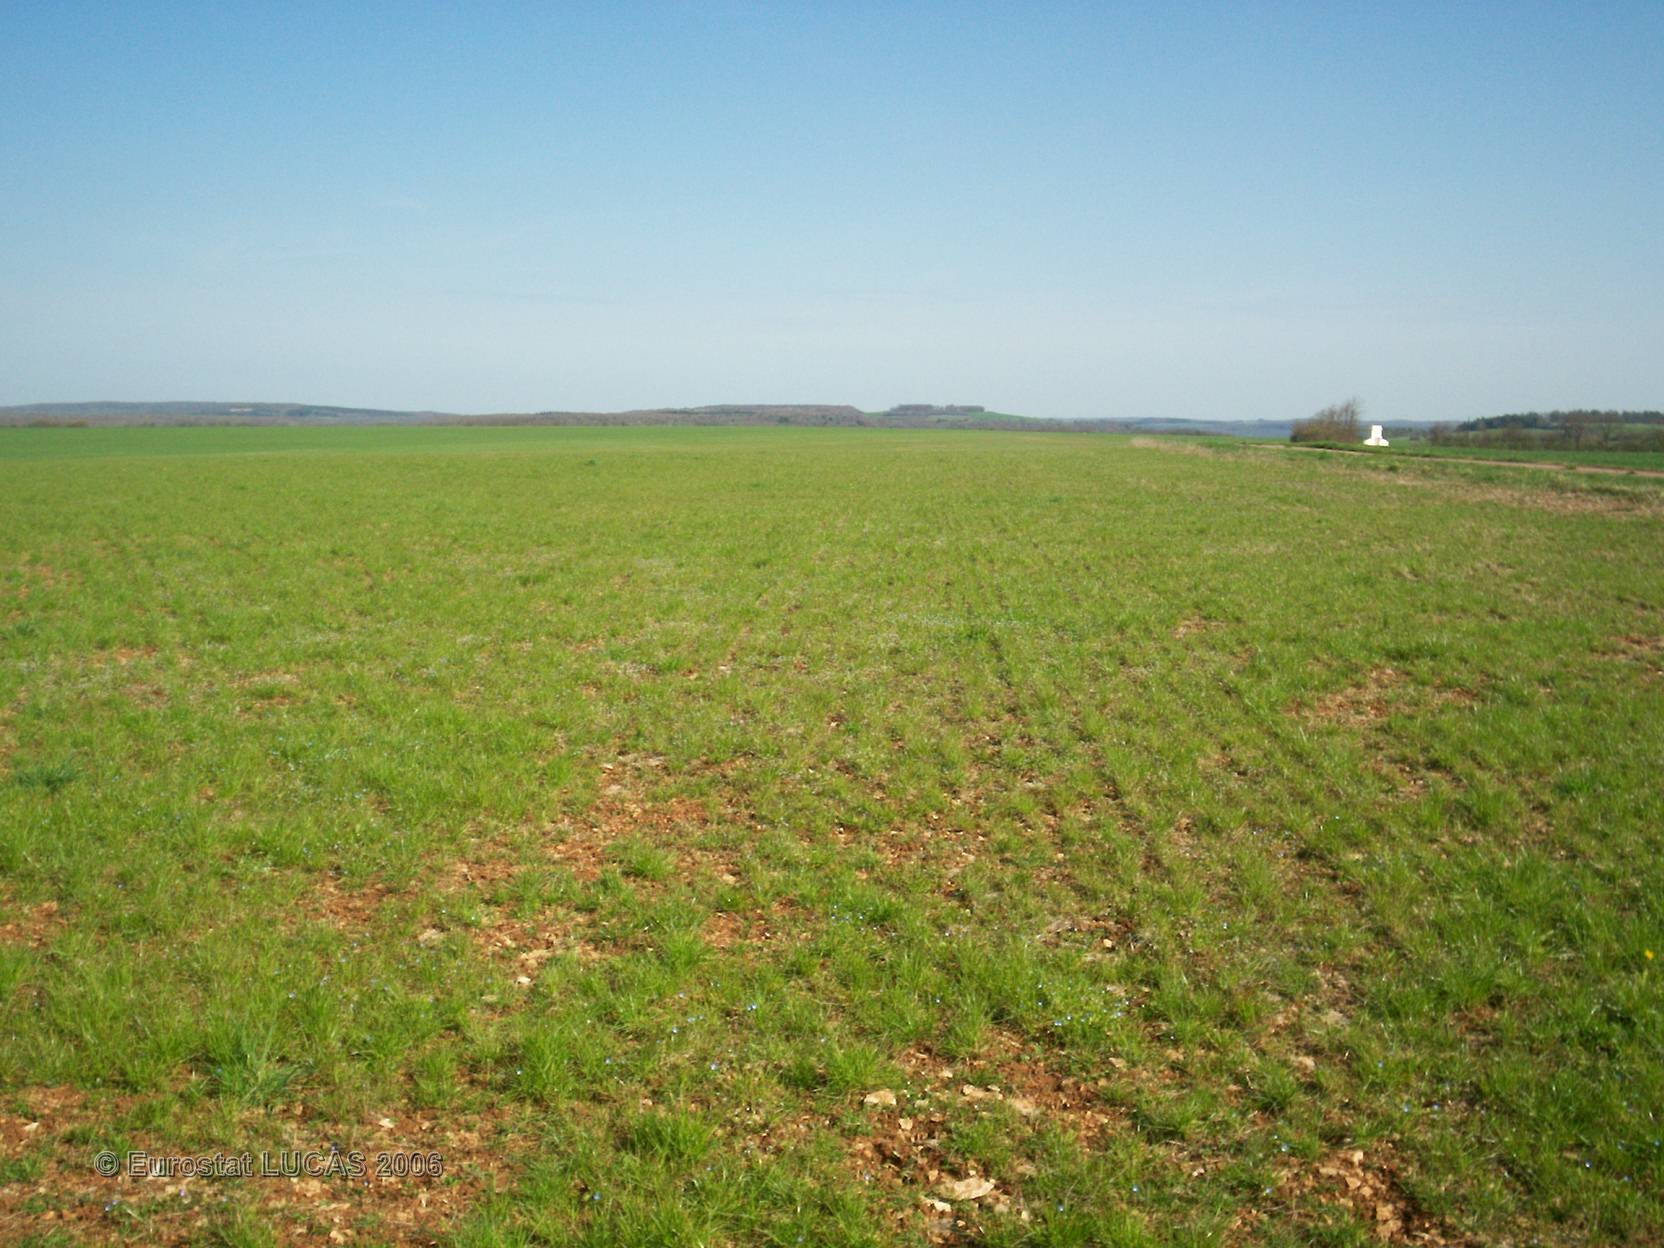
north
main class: Grassland
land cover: Grassland without tree/shrub cover
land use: Fallow land
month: April
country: FR
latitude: 47.4228
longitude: 4.5778
